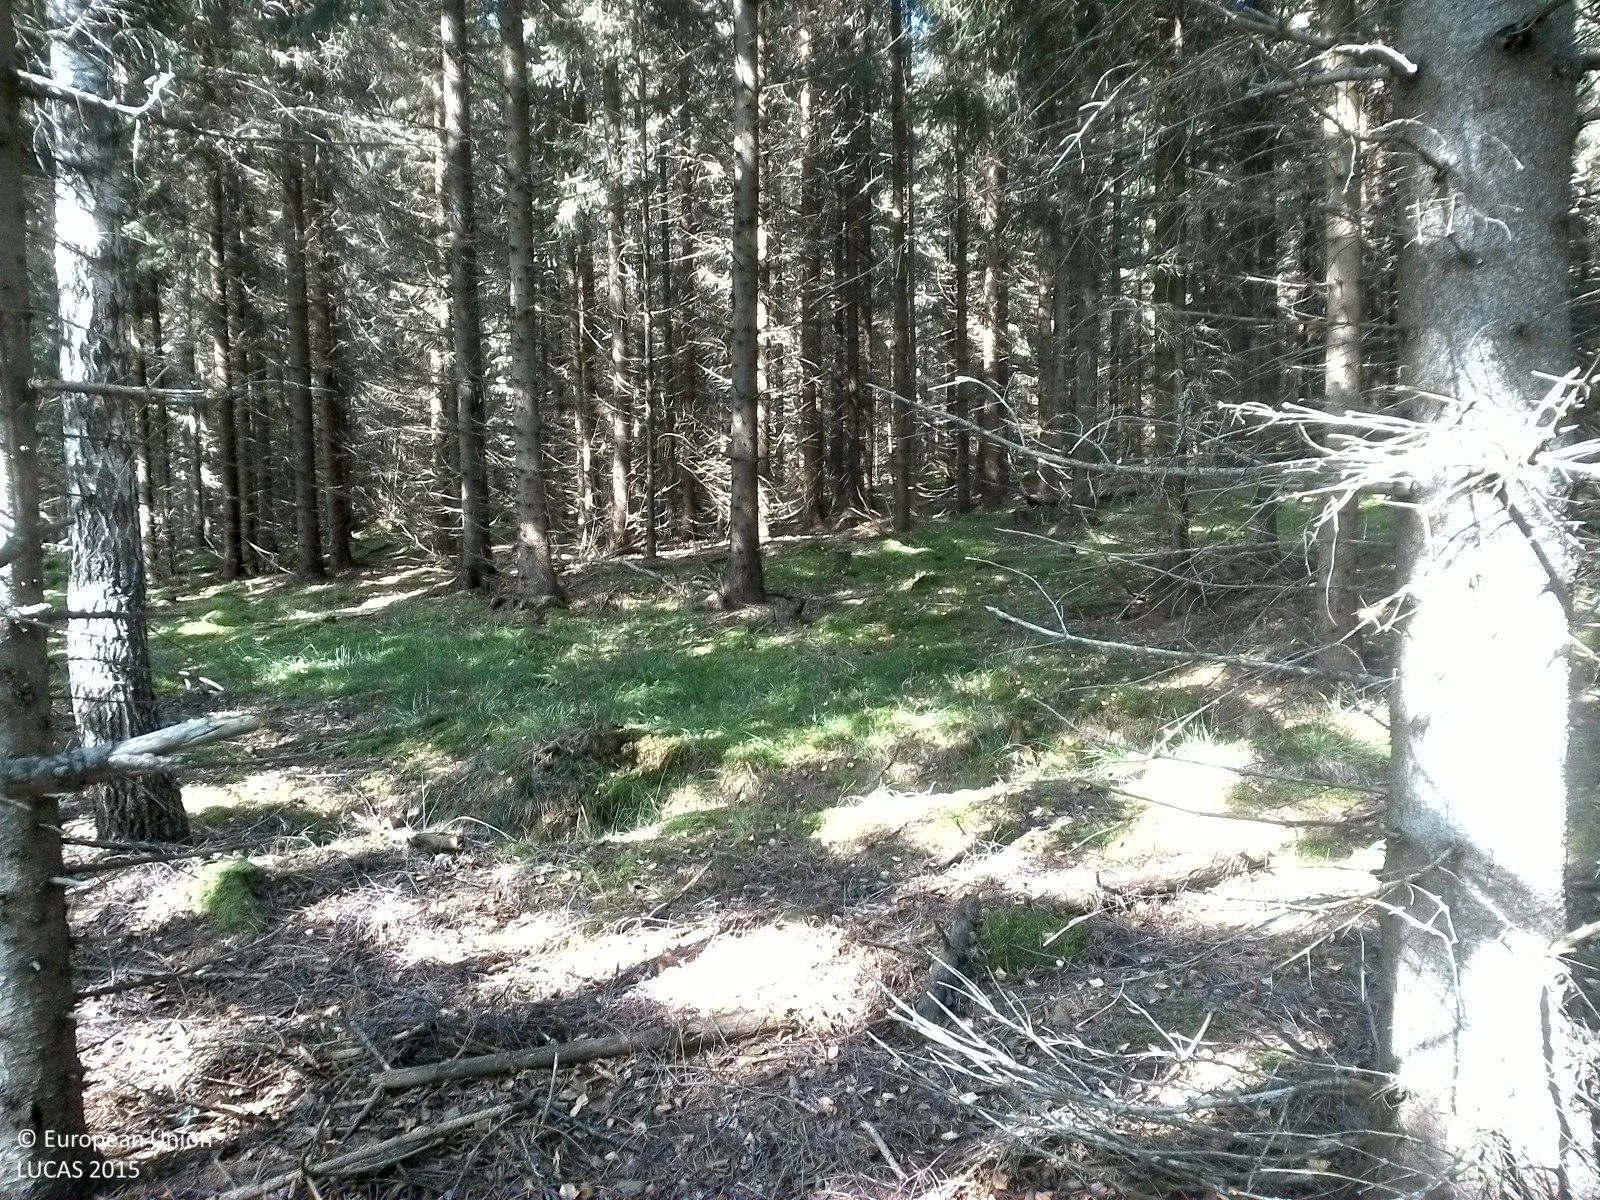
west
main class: Woodland
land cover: Spruce dominated coniferous woodland
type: boreal forest
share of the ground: 50 - 75 %
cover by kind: coniferous forest trees 70 %, herbaceous plants 10 %, lichens and mosses 10 %, unconsolidated bare surface 10 %
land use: Forestry
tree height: > 5 m
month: August
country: SE
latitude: 58.9489
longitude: 15.6420
